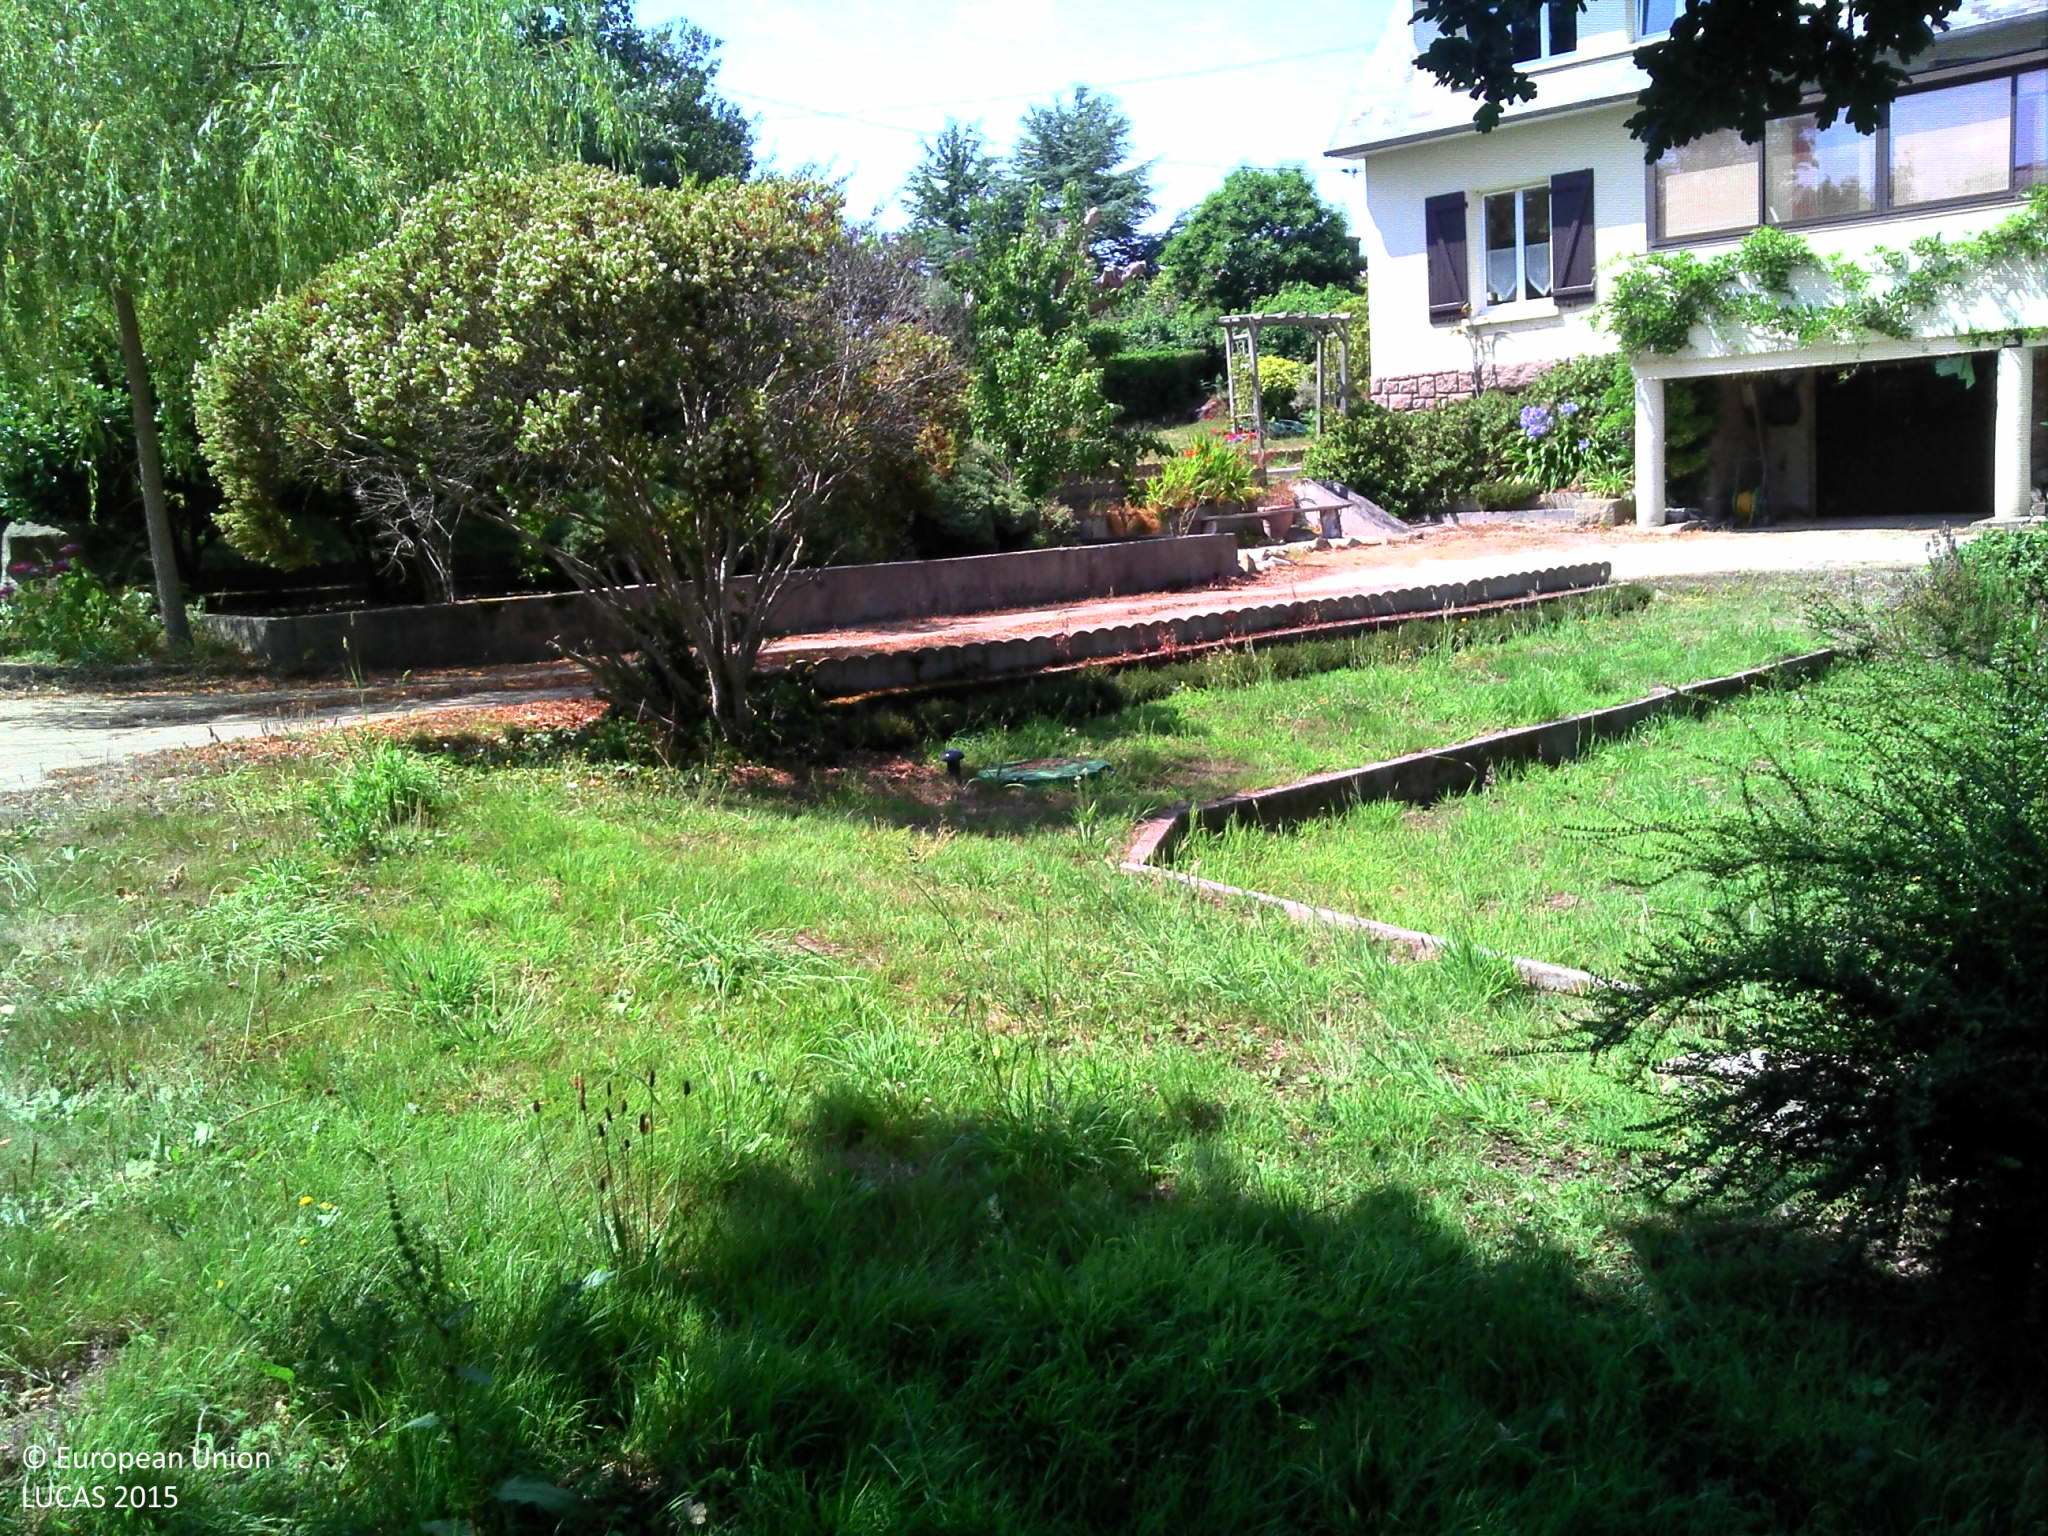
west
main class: Grassland
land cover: Grassland with sparse tree/shrub cover
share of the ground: > 75 %
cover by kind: herbaceous plants 80 %, unconsolidated bare surface 15 %, coniferous forest trees 5 %
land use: Community services
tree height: > 5 m
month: July
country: FR
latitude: 48.7845
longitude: -3.5689
